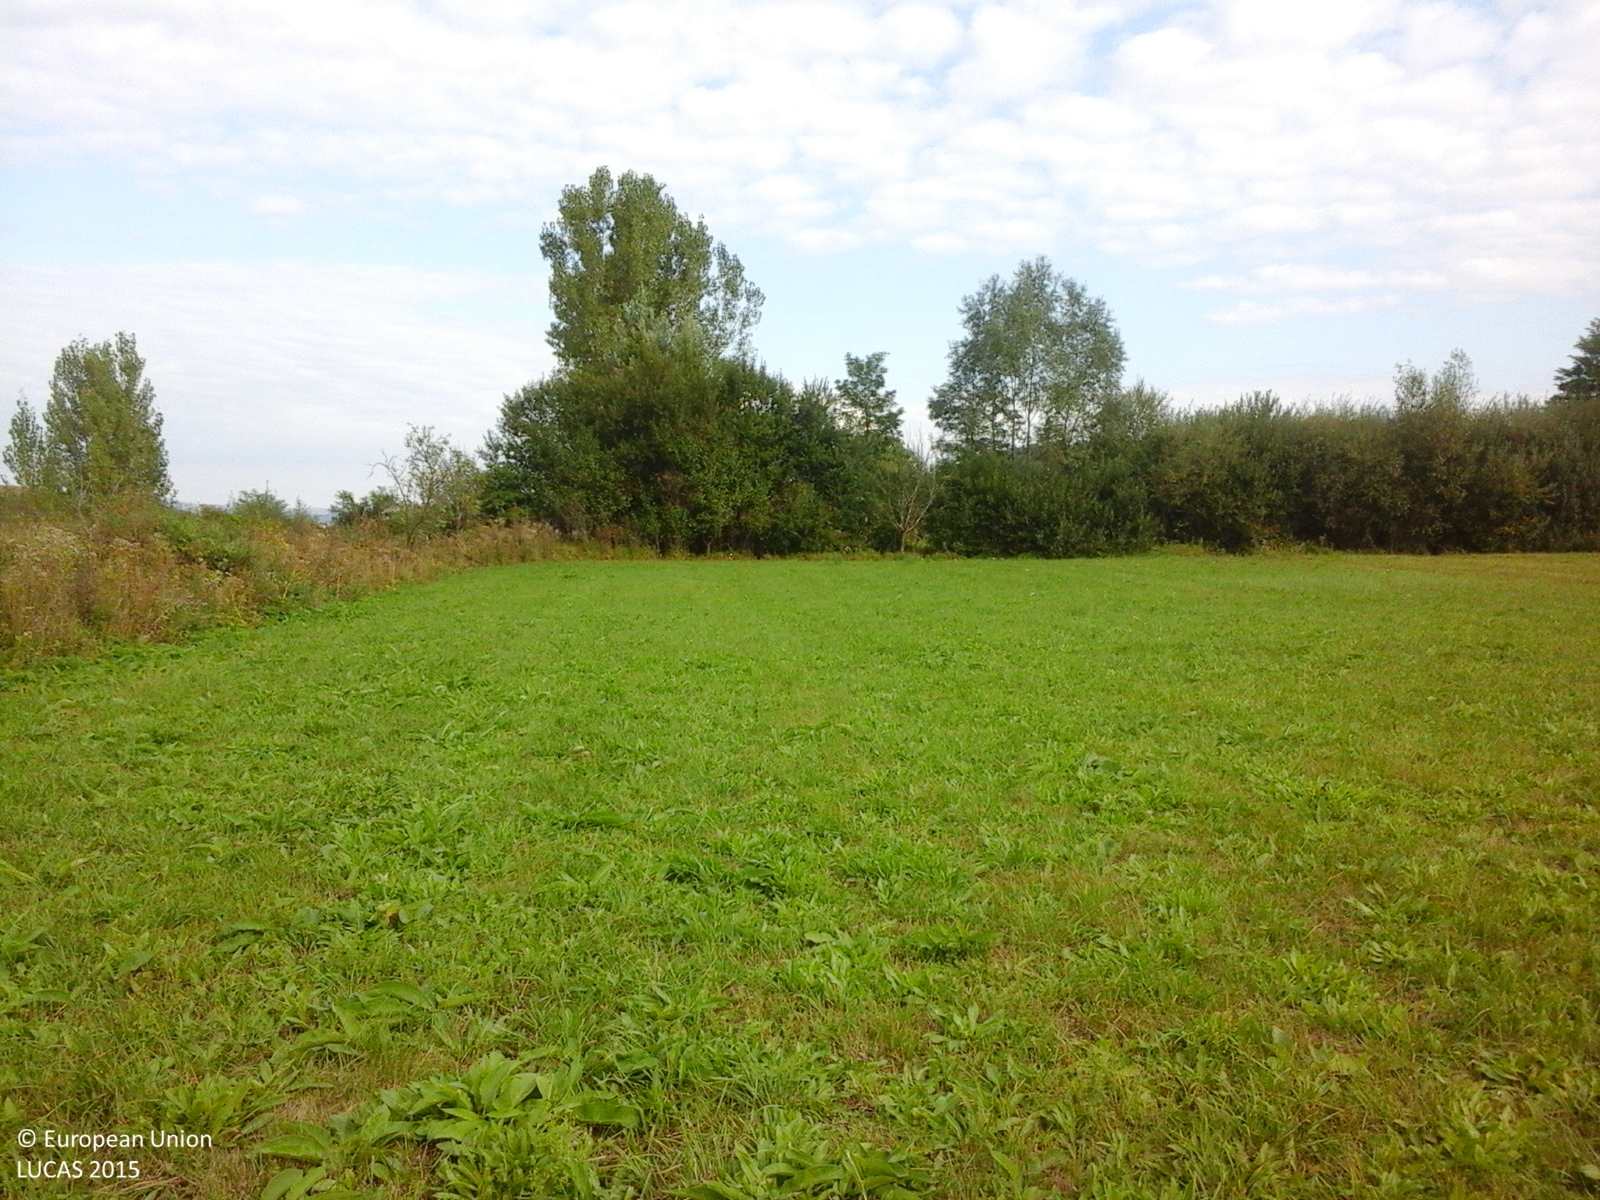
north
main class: Grassland
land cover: Grassland without tree/shrub cover
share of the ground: > 75 %
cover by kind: herbaceous plants 100 %
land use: Agriculture (excluding fallow land and kitchen gardens)
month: September
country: RO
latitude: 47.3927
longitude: 23.1699
